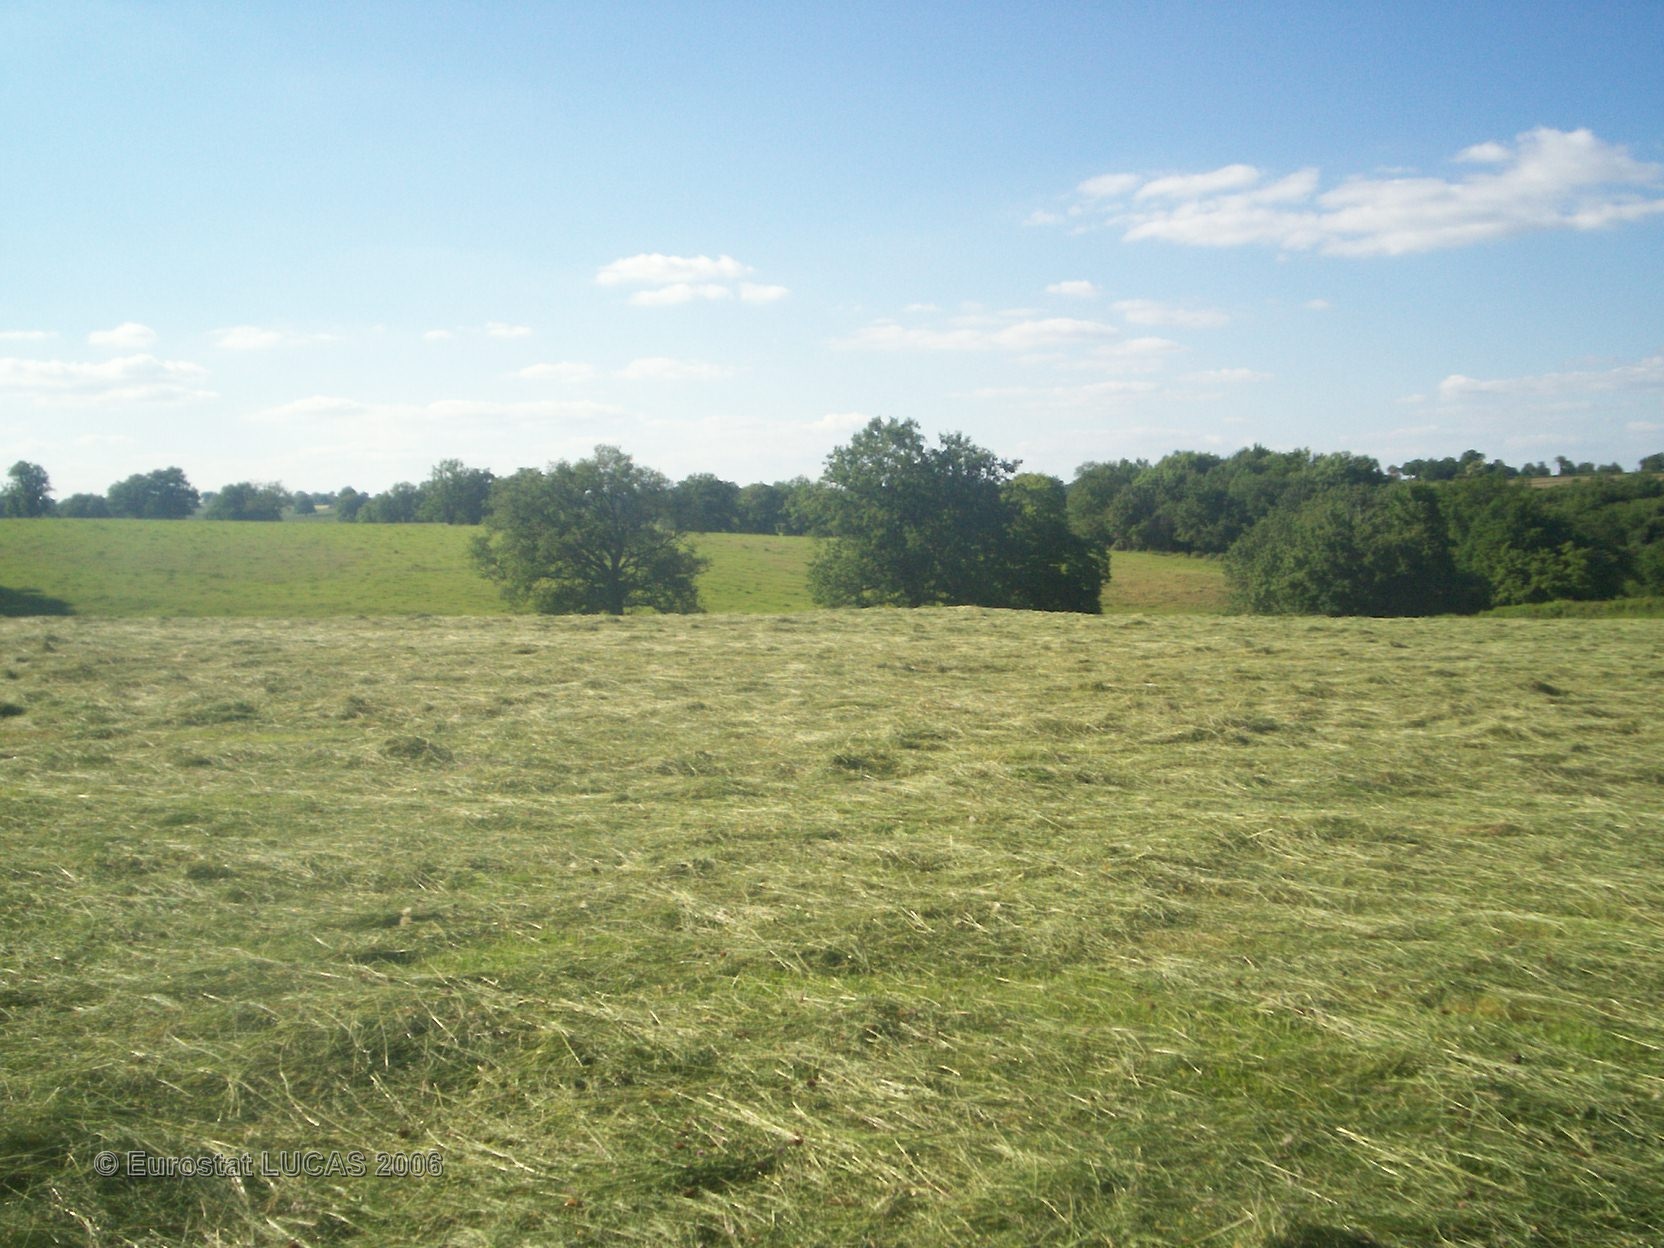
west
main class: Grassland
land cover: Grassland without tree/shrub cover
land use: Agriculture (excluding fallow land and kitchen gardens)
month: June
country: FR
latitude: 46.3126
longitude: 3.1548
